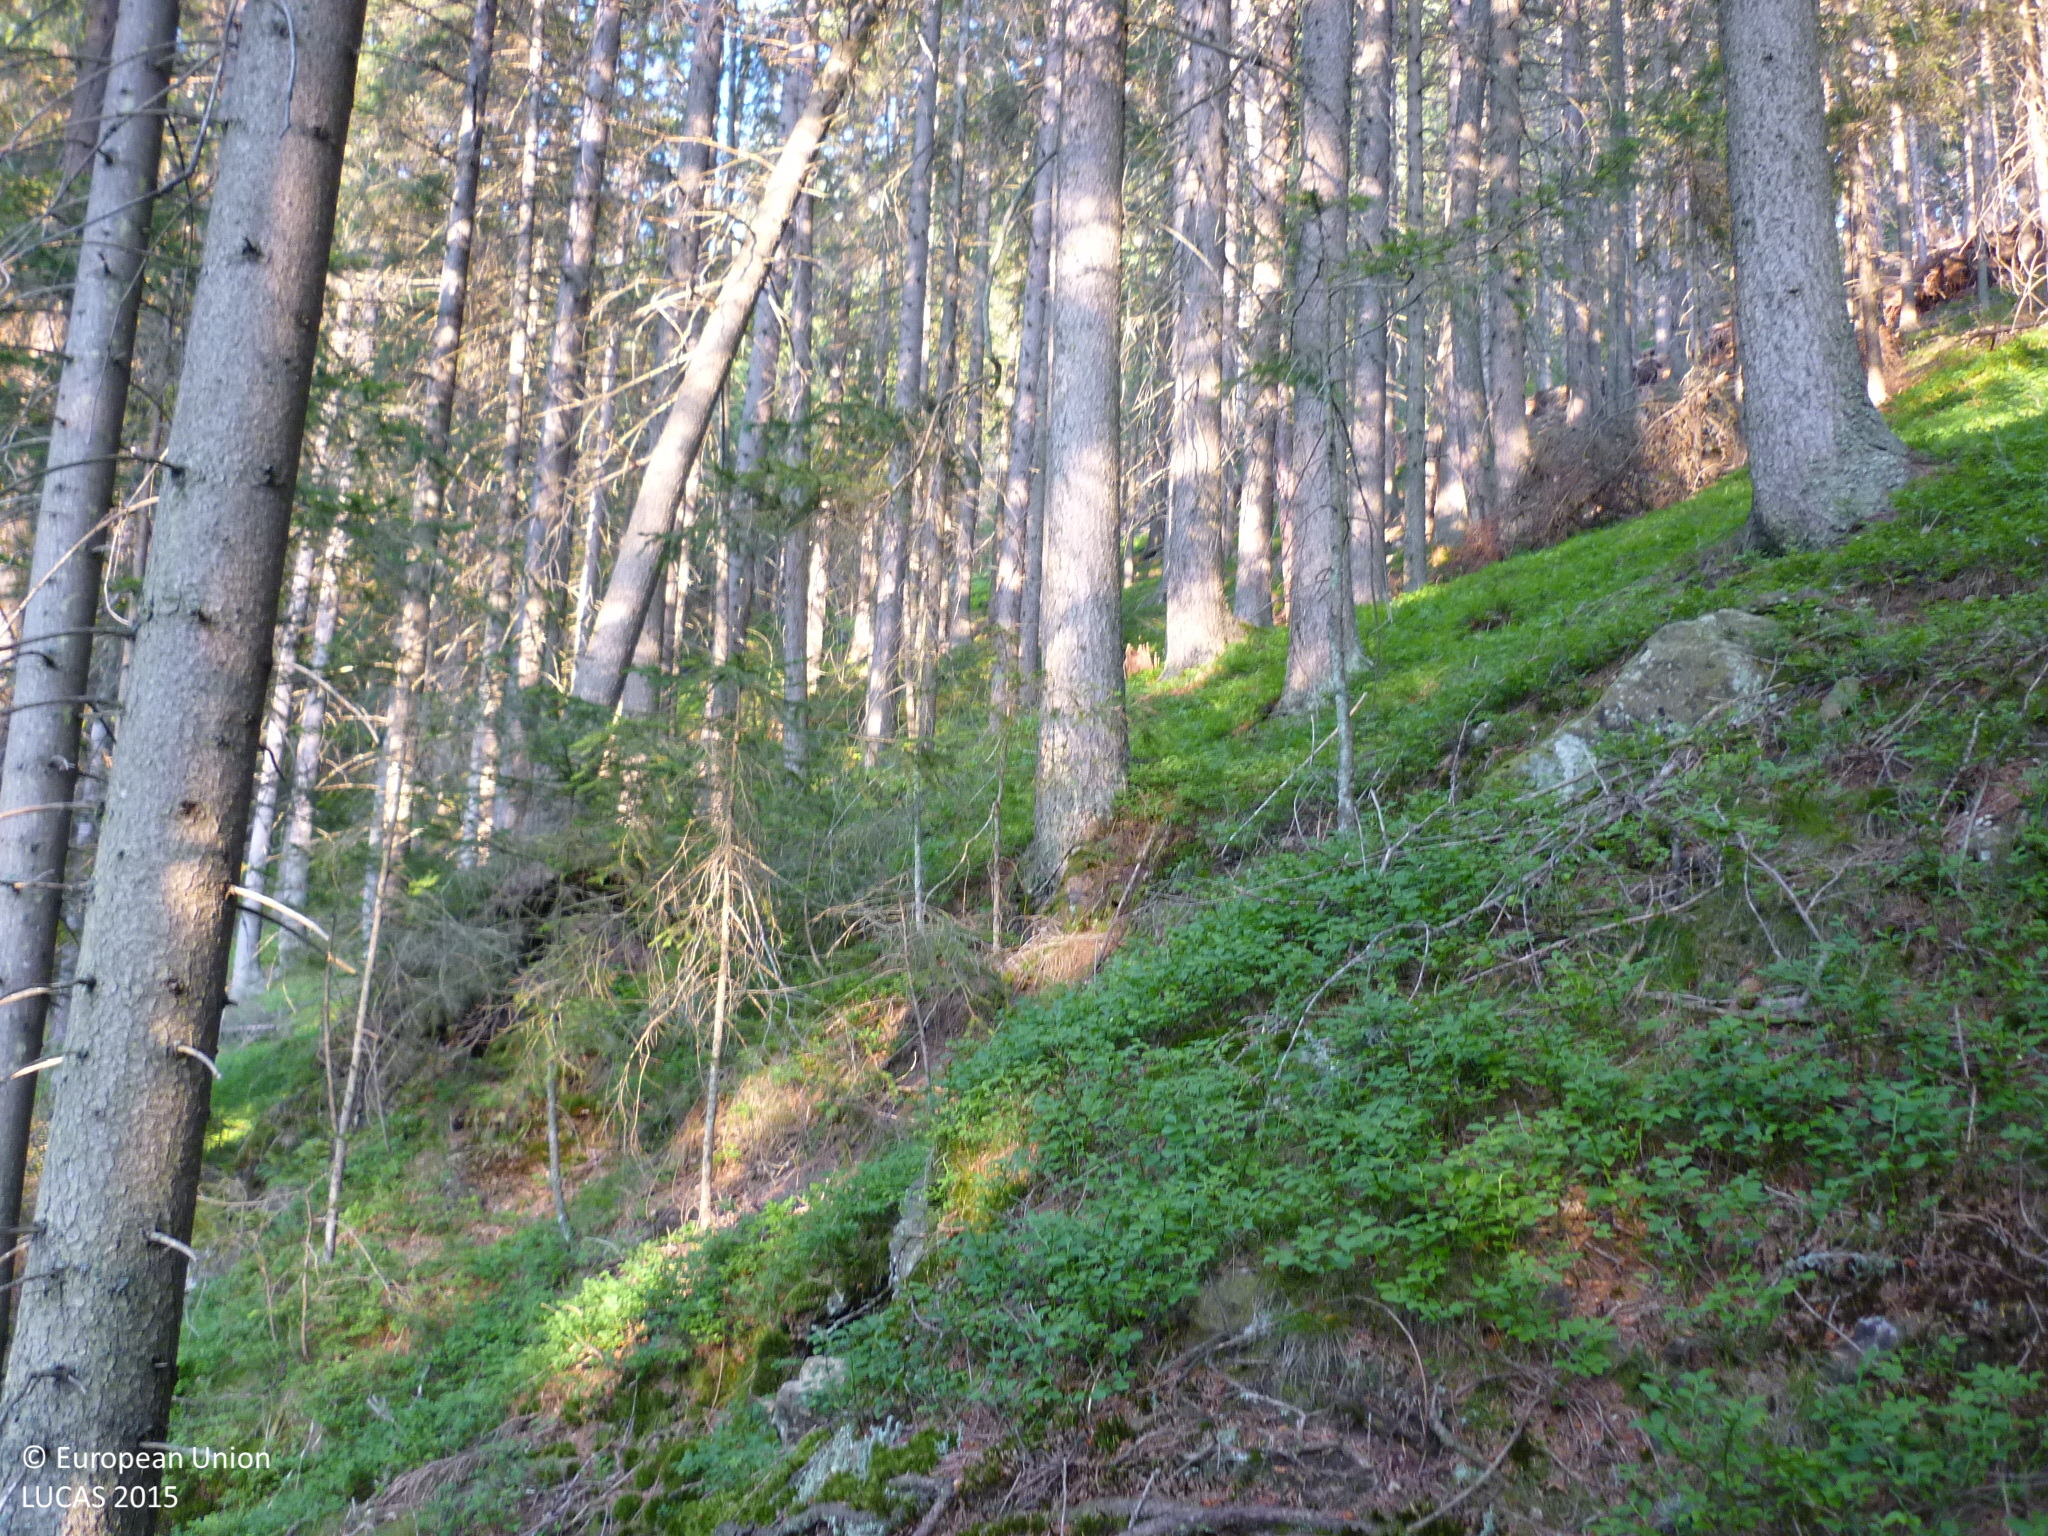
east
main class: Woodland
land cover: Spruce dominated coniferous woodland
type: alpine coniferous forest
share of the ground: > 75 %
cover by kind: coniferous forest trees 90 %, shrubs 10 %
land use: Forestry
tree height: > 5 m
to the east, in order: Spruce dominated coniferous woodland; Tracks; Spruce dominated coniferous woodland; Fences; Grassland with sparse tree/shrub cover; Tracks; Spruce dominated coniferous woodland
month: July
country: AT
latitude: 47.0574
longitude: 14.7513
